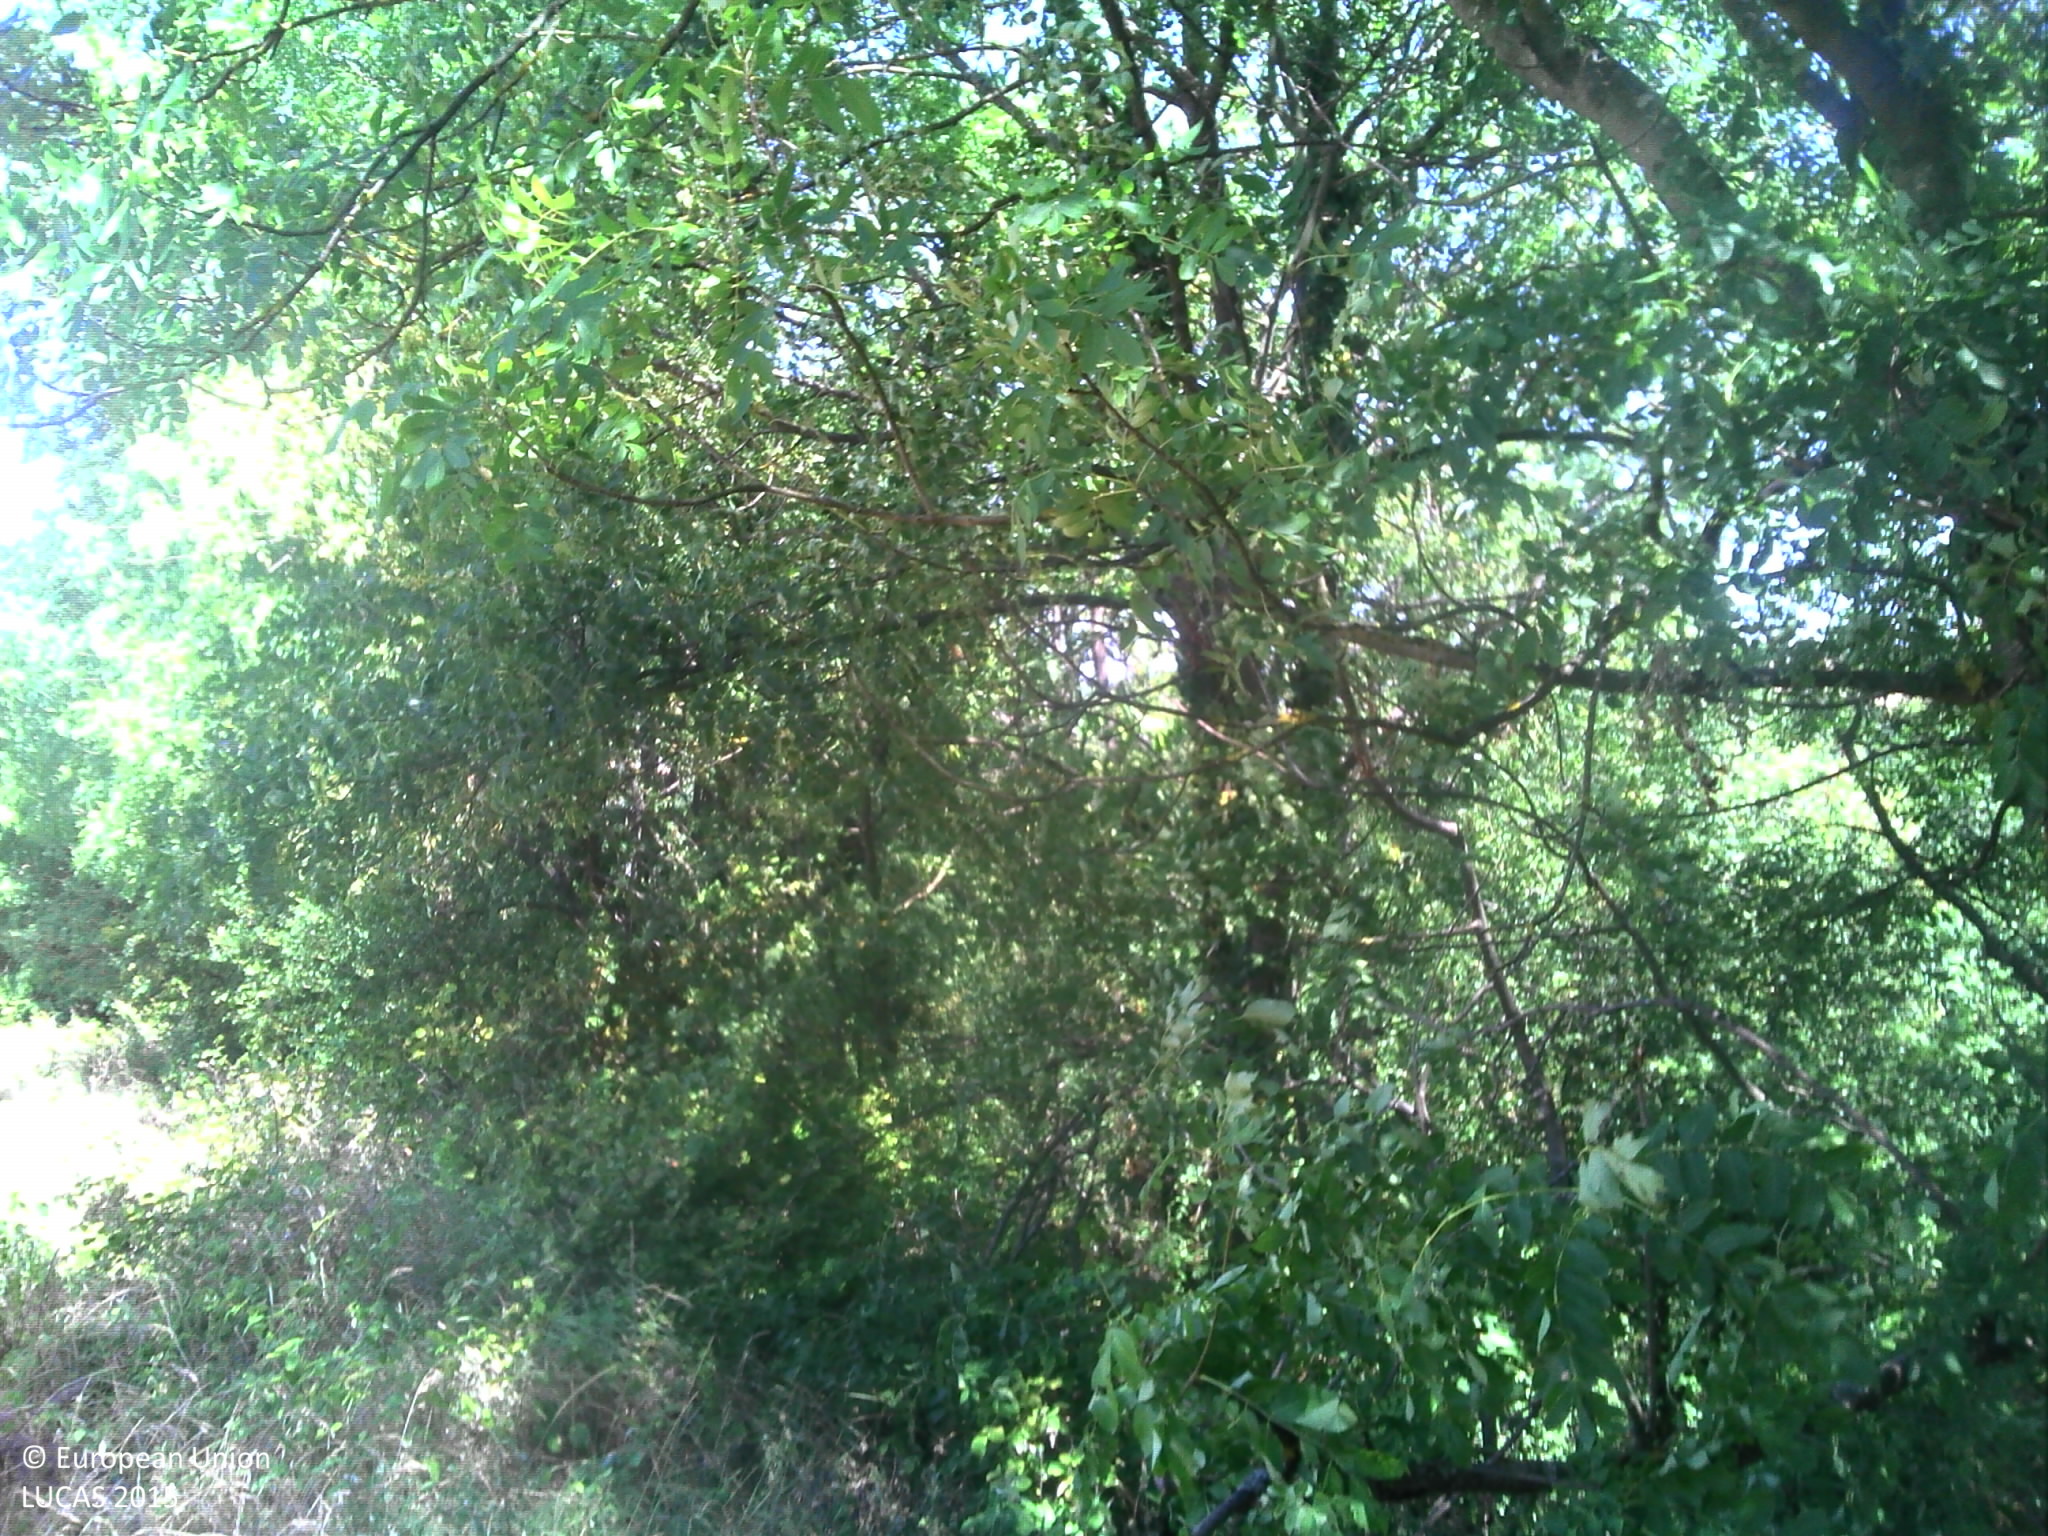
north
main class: Woodland
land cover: Broadleaved woodland
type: mesophytic deciduous forest
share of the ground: > 75 %
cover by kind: broadleaved forest trees 90 %, herbaceous plants 10 %
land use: Forestry
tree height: > 5 m
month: July
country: FR
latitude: 45.5601
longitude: 4.8668
